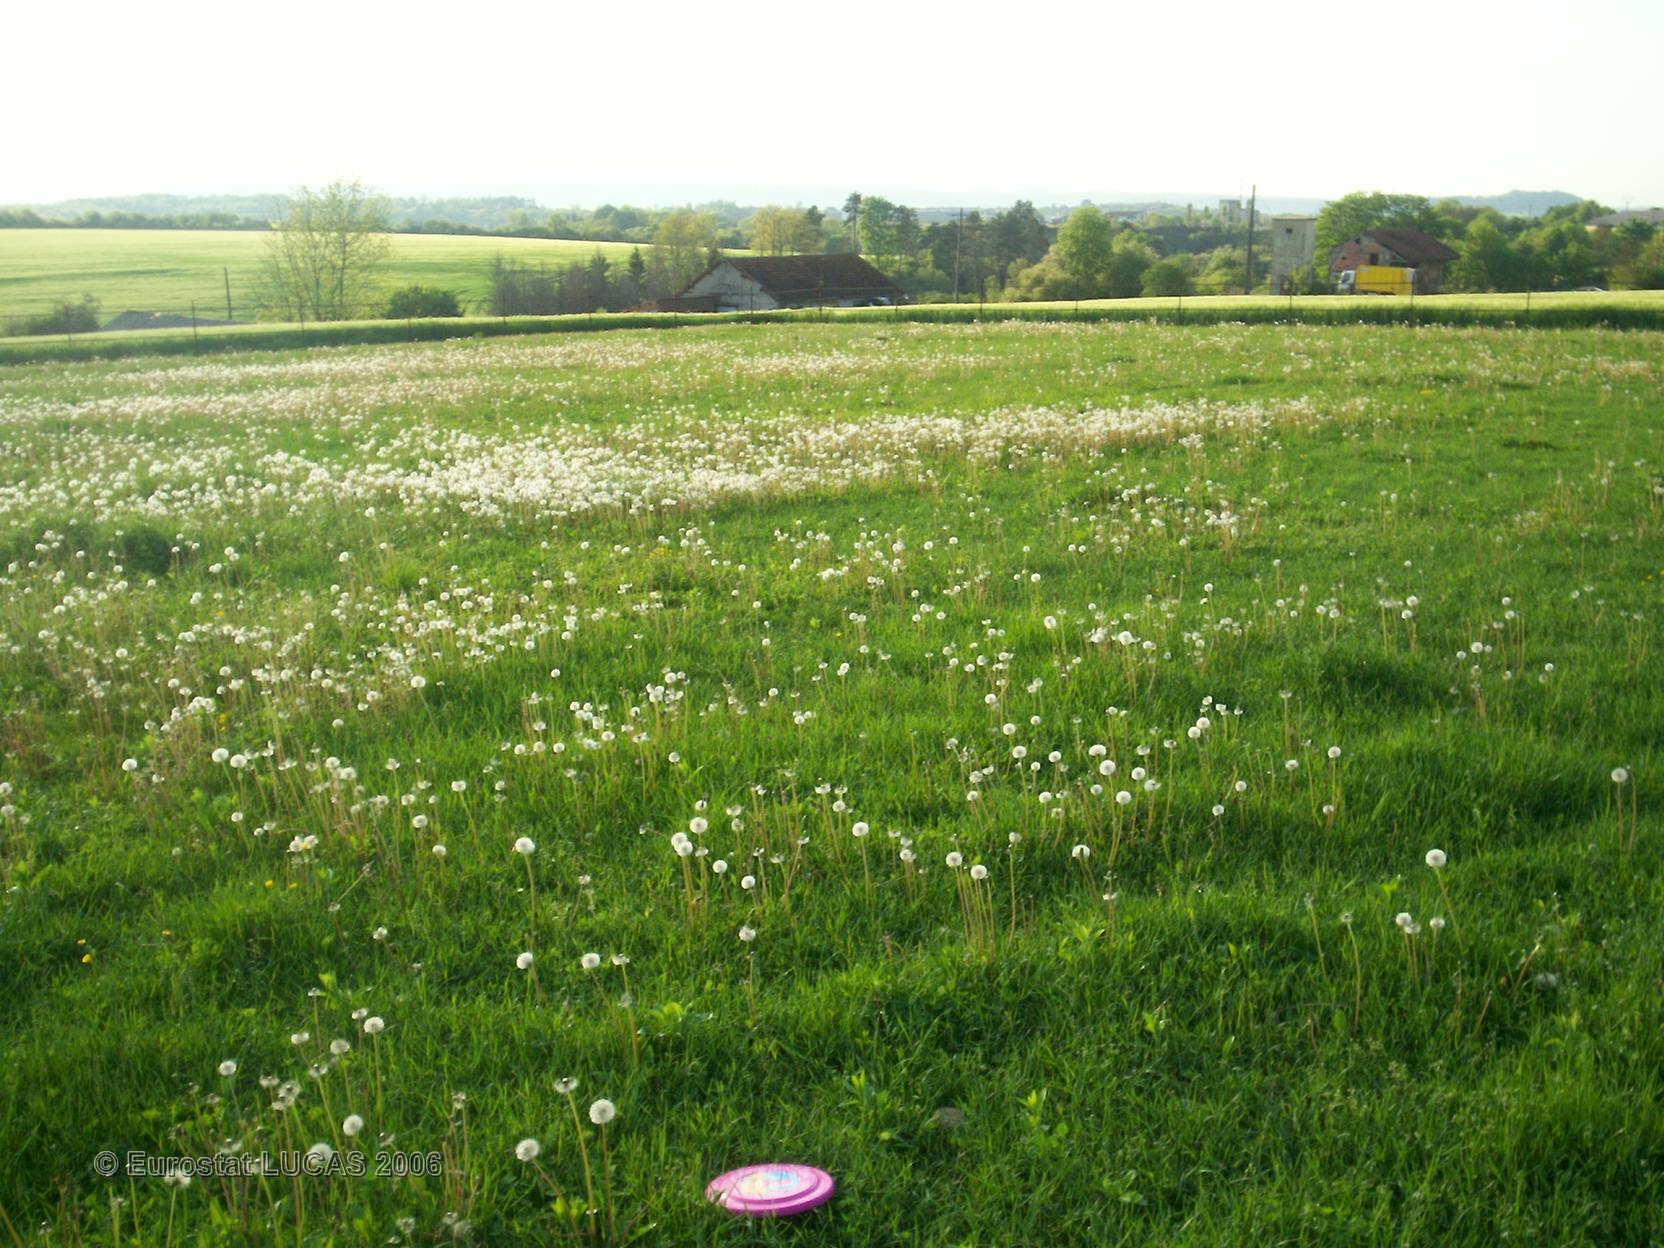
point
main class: Grassland
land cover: Grassland without tree/shrub cover
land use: Agriculture (excluding fallow land and kitchen gardens)
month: May
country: FR
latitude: 47.8547
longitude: 4.5588
